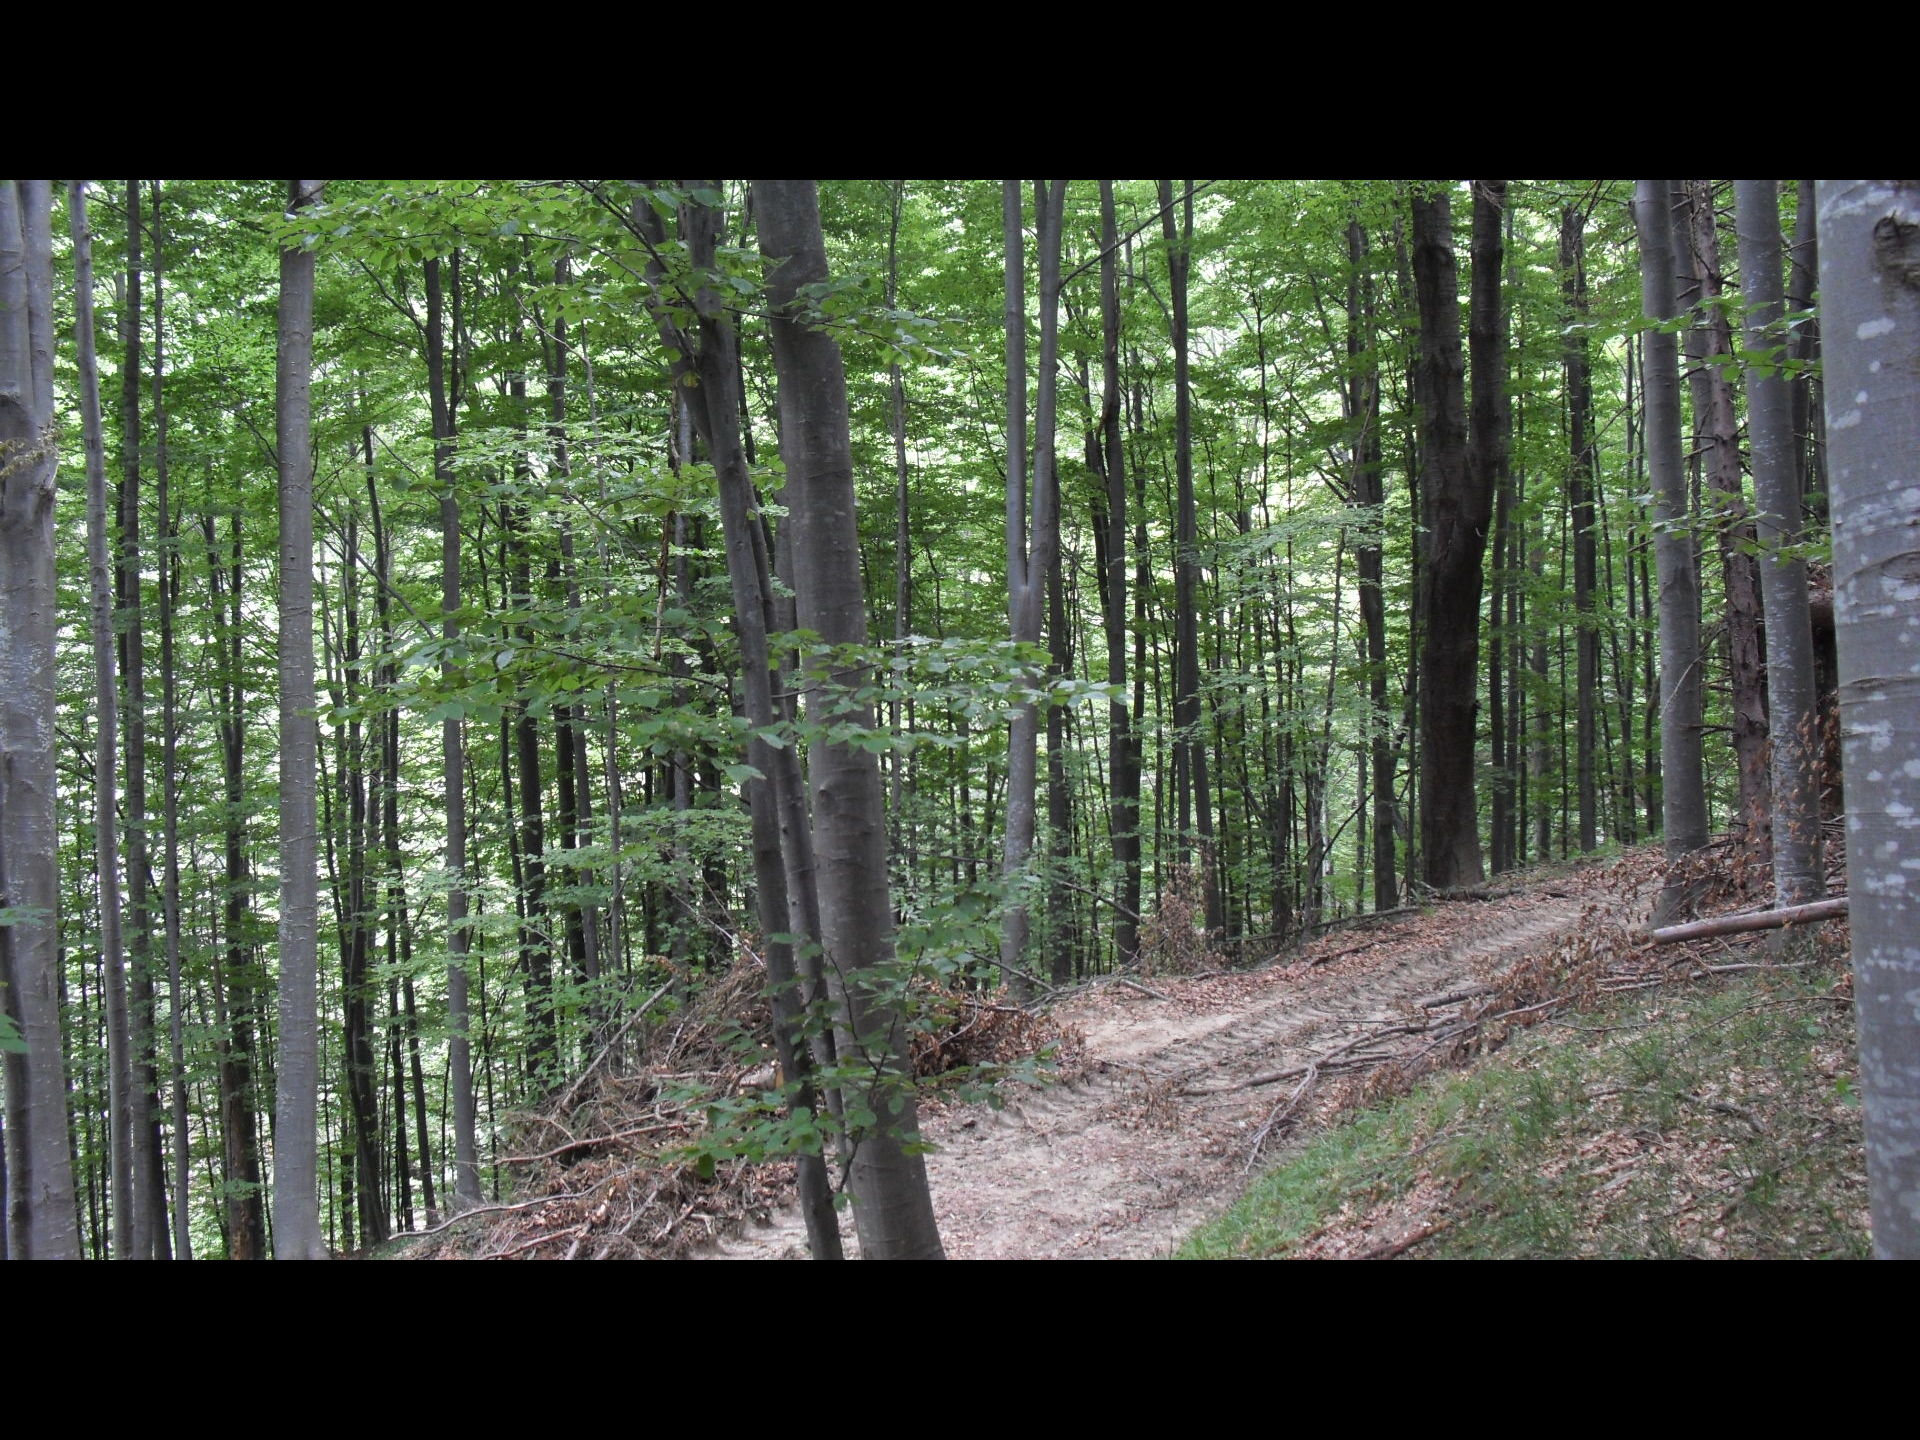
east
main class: Woodland
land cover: Other mixed woodland
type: hemiboreal forest and nemoral coniferous forest and mixed broadleaved-coniferous forest
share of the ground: > 75 %
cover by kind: coniferous forest trees 50 %, broadleaved forest trees 40 %, herbaceous plants 10 %
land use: Forestry
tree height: > 5 m
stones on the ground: < 10 %
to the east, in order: Other mixed woodland; Tracks; Broadleaved woodland; Rivers and streams; Broadleaved woodland; Tracks; Broadleaved woodland; Rivers and streams; Broadleaved woodland; Tracks; Broadleaved woodland
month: August
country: BG
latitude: 43.1437
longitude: 23.1554
